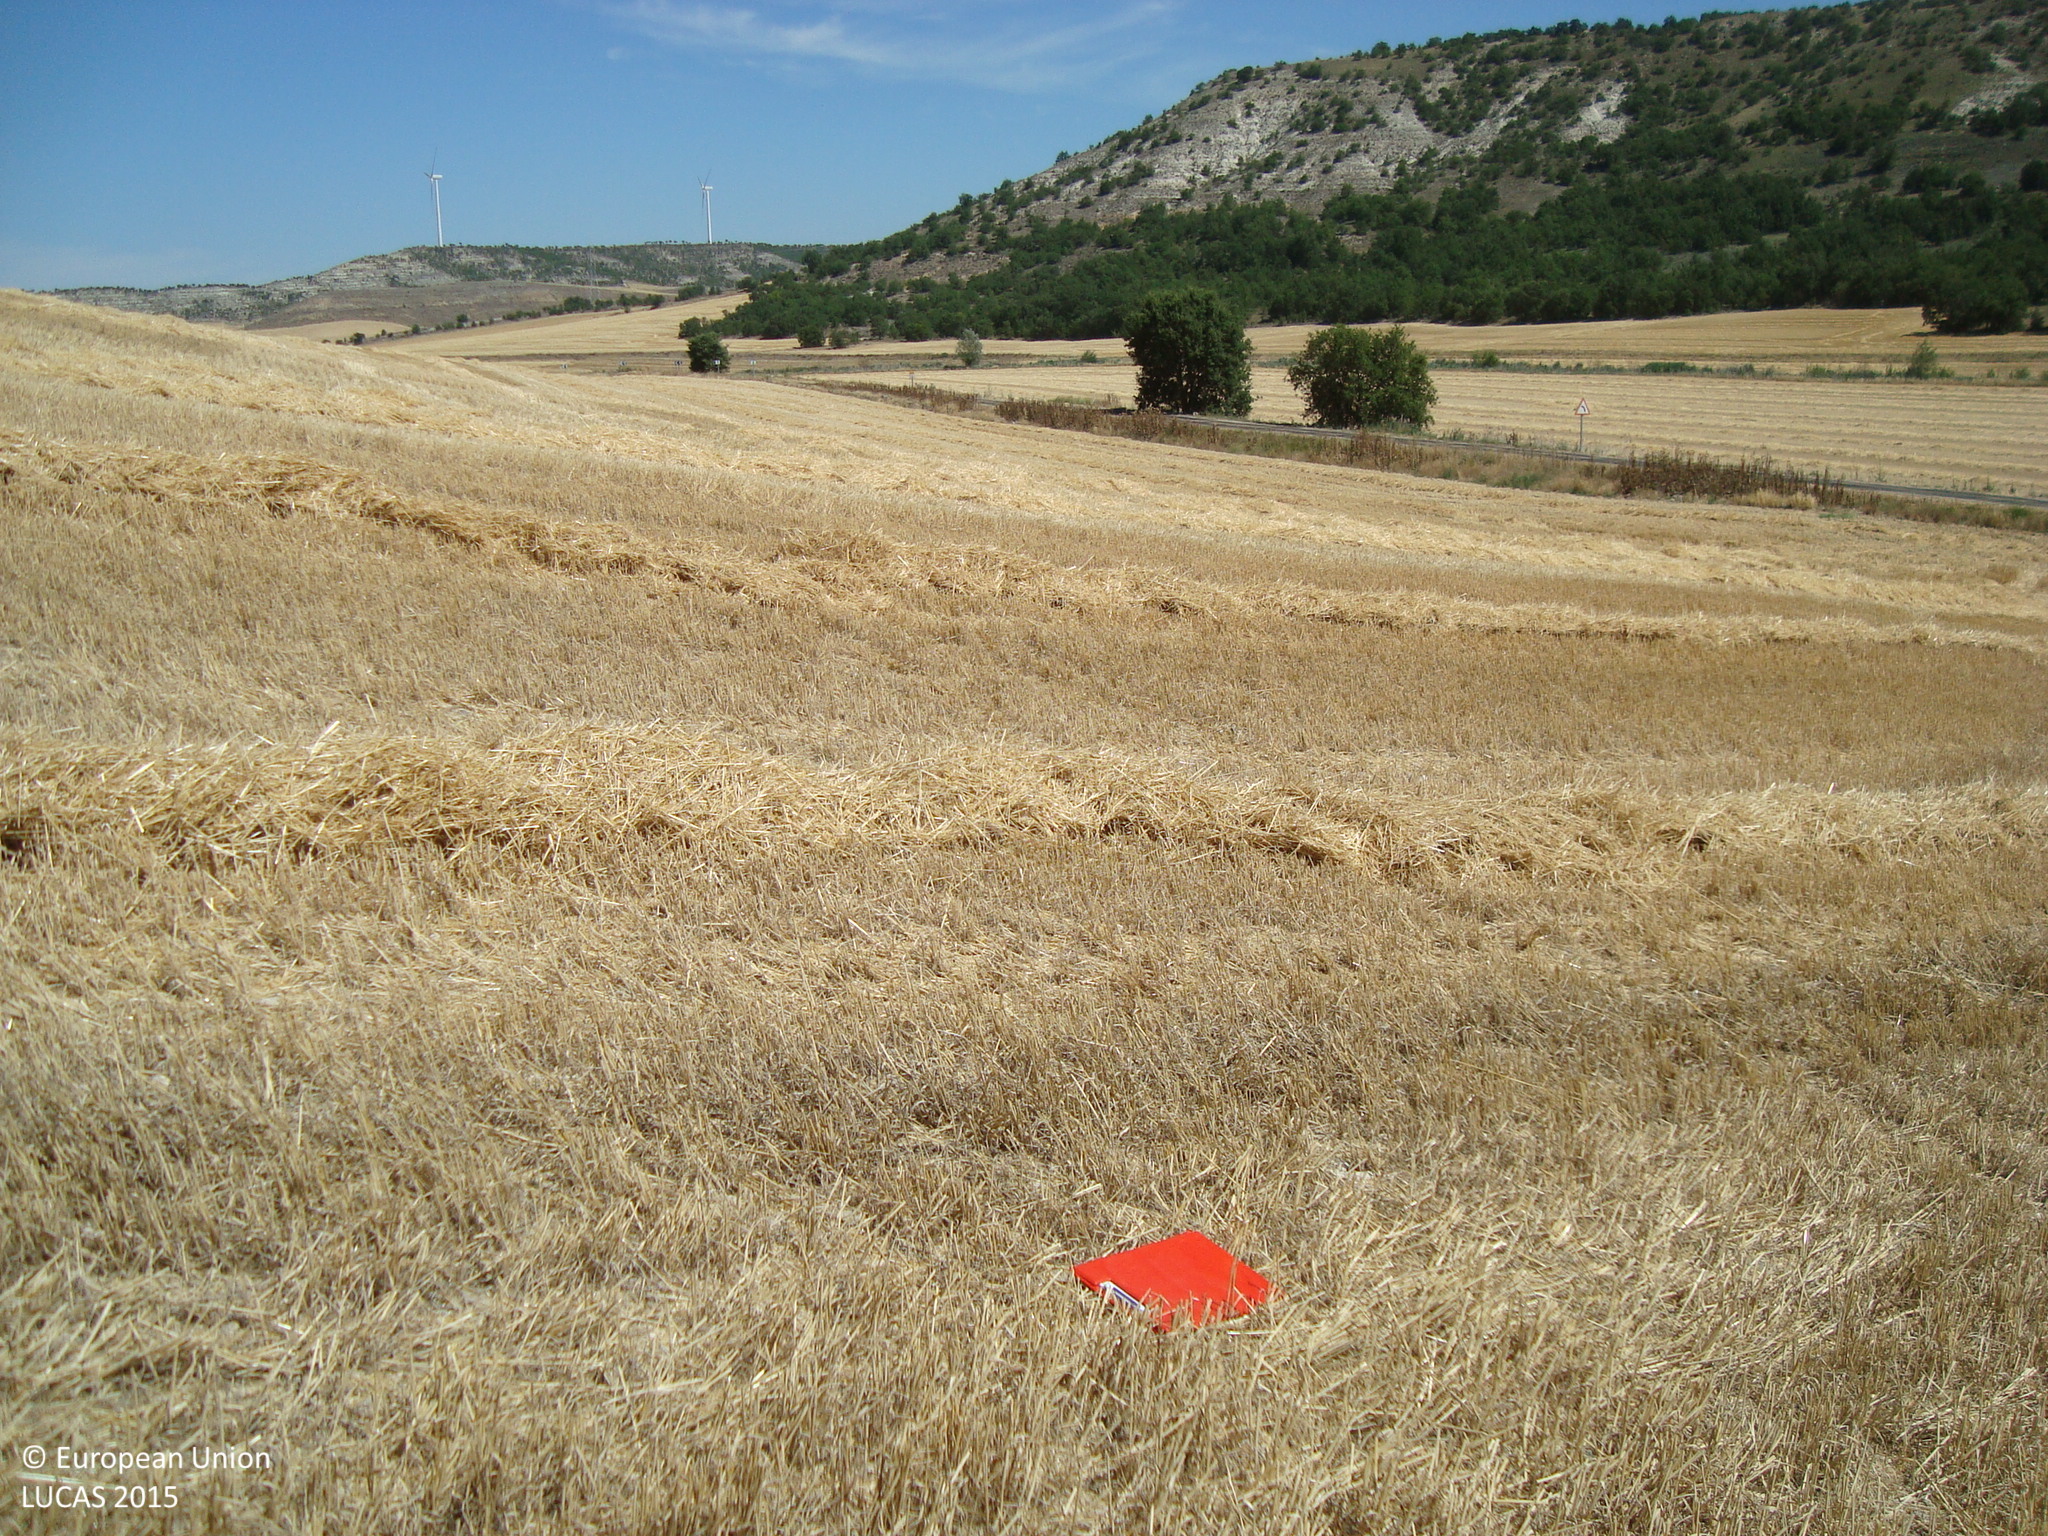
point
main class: Cropland
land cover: Common wheat
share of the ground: > 75 %
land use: Agriculture (excluding fallow land and kitchen gardens)
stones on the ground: 10 - 25 %
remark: Harvested field
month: July
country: ES
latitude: 42.0099
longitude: -4.2287
